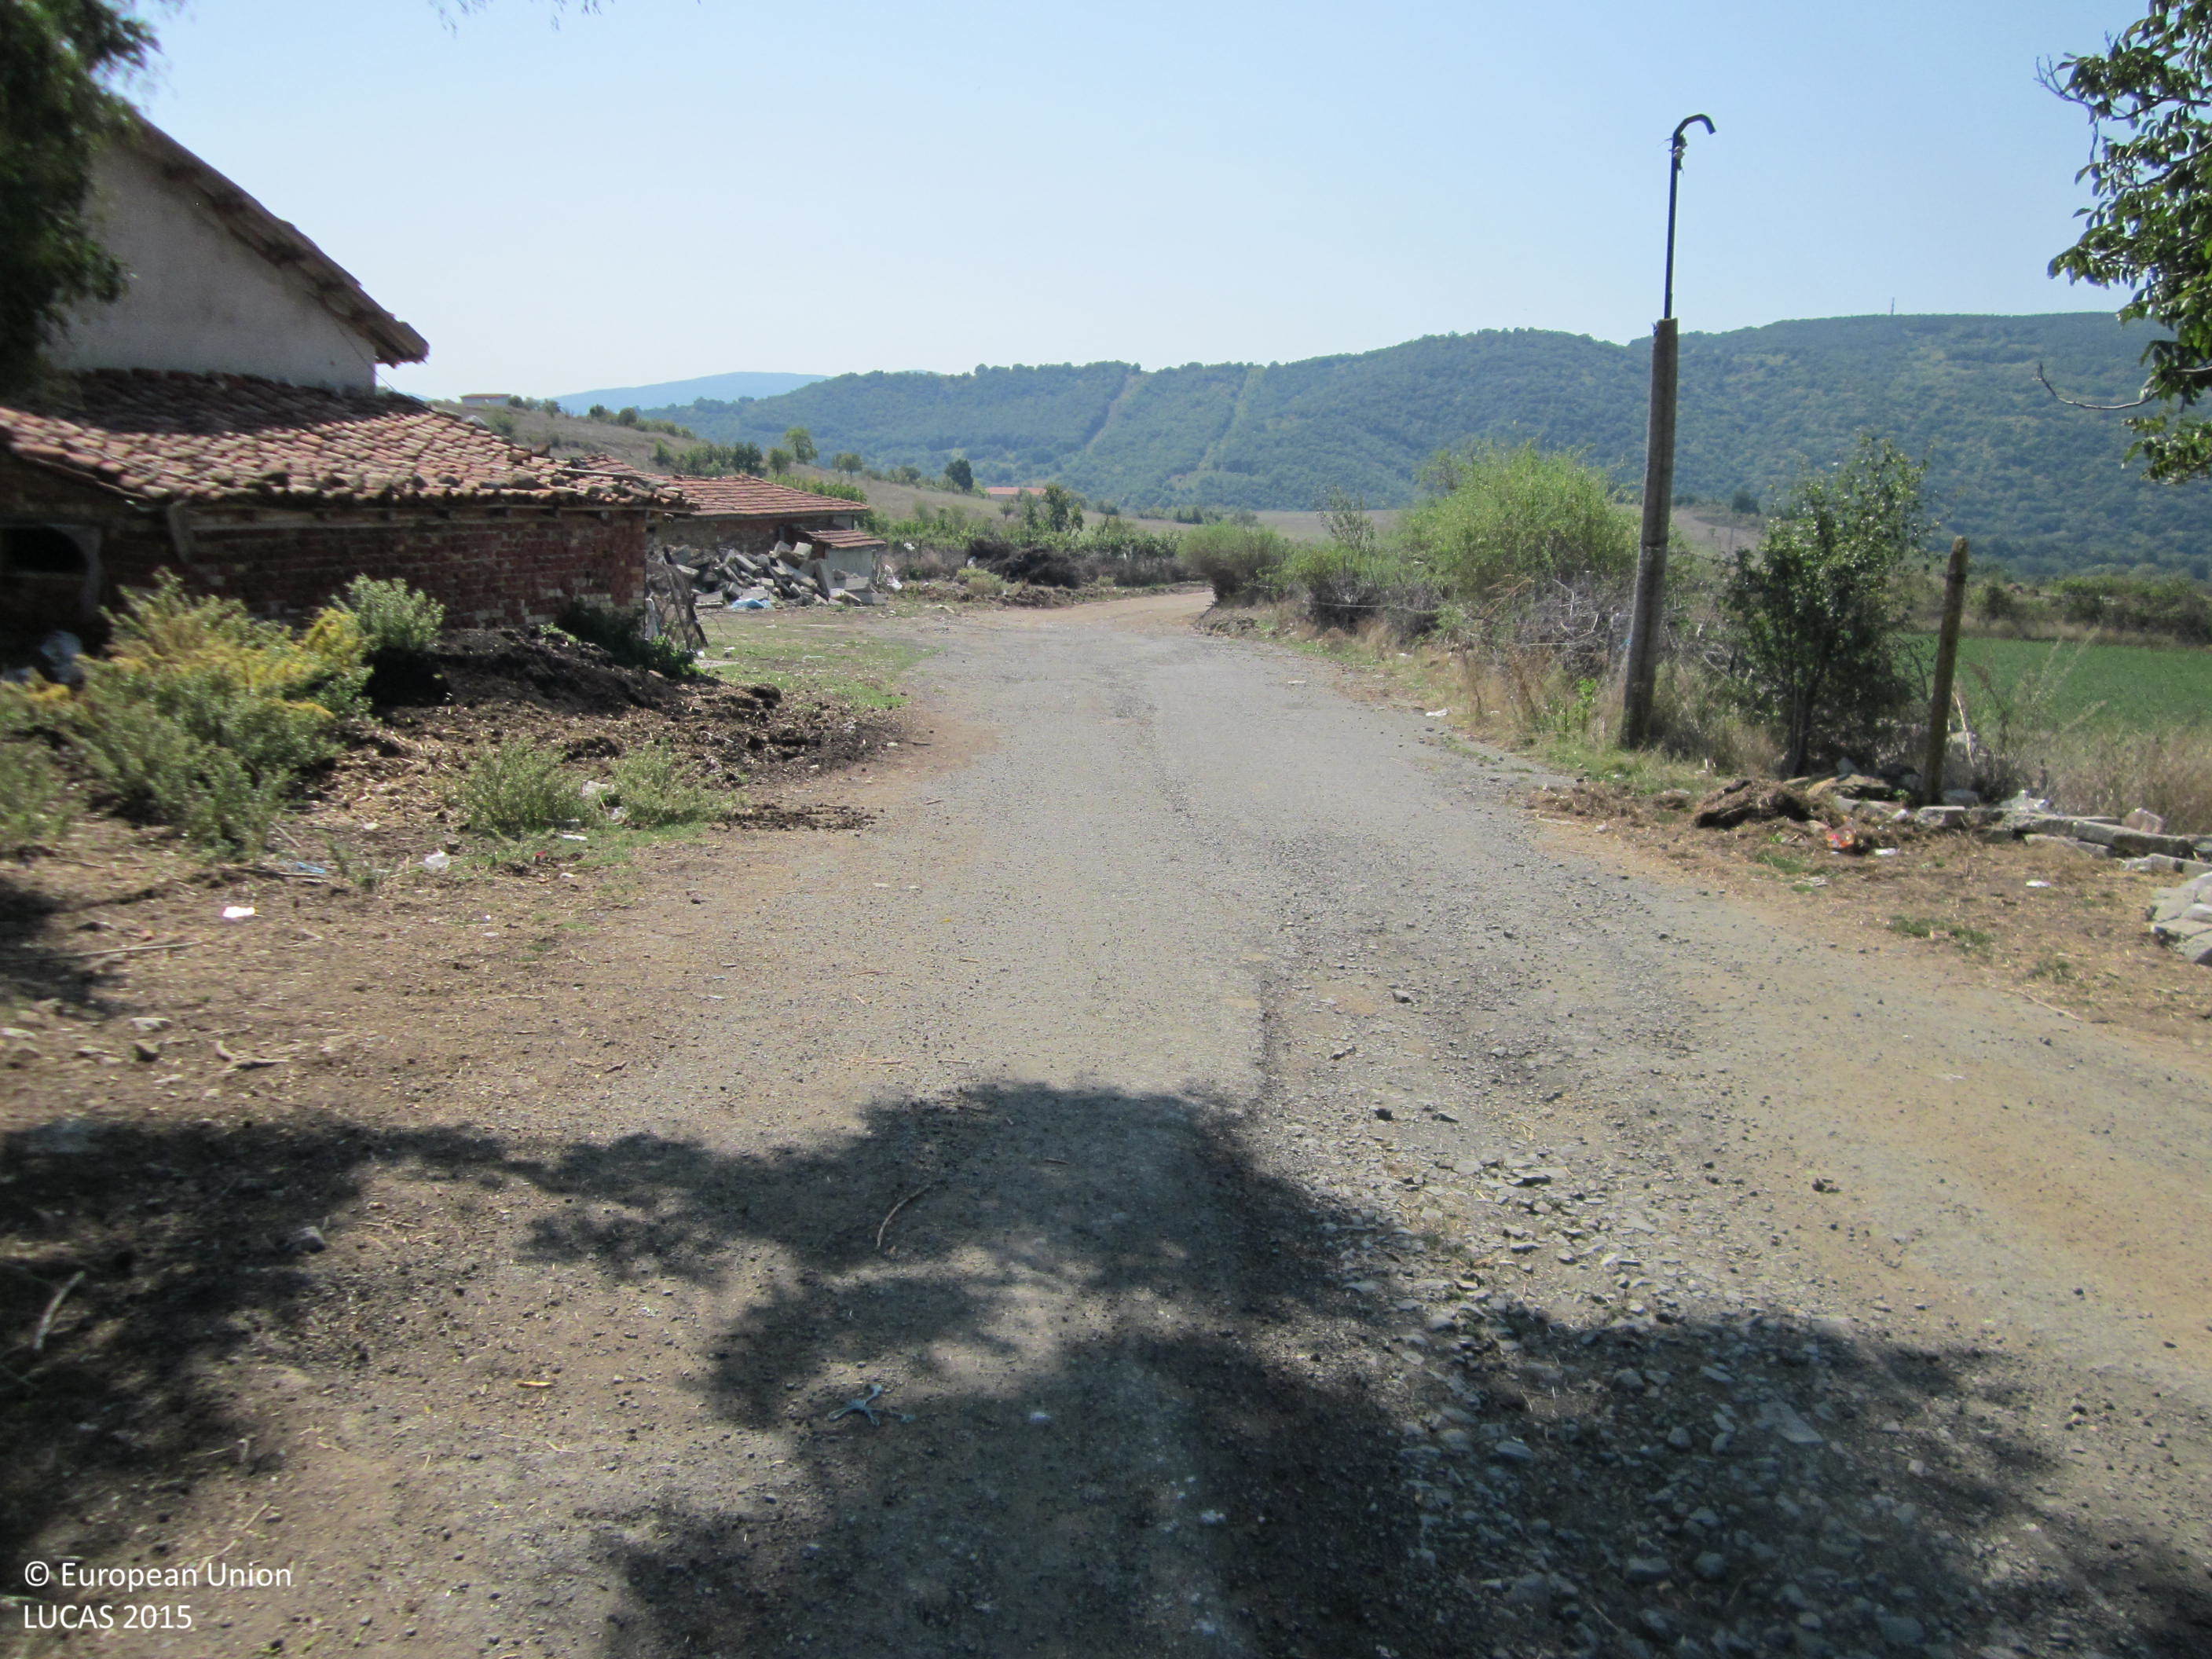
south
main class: Grassland
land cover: Grassland with sparse tree/shrub cover
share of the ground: > 75 %
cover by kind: herbaceous plants 80 %, unconsolidated bare surface 10 %, broadleaved forest trees 5 %, shrubs 5 %
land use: Residential
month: September
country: BG
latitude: 42.8853
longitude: 26.9688
